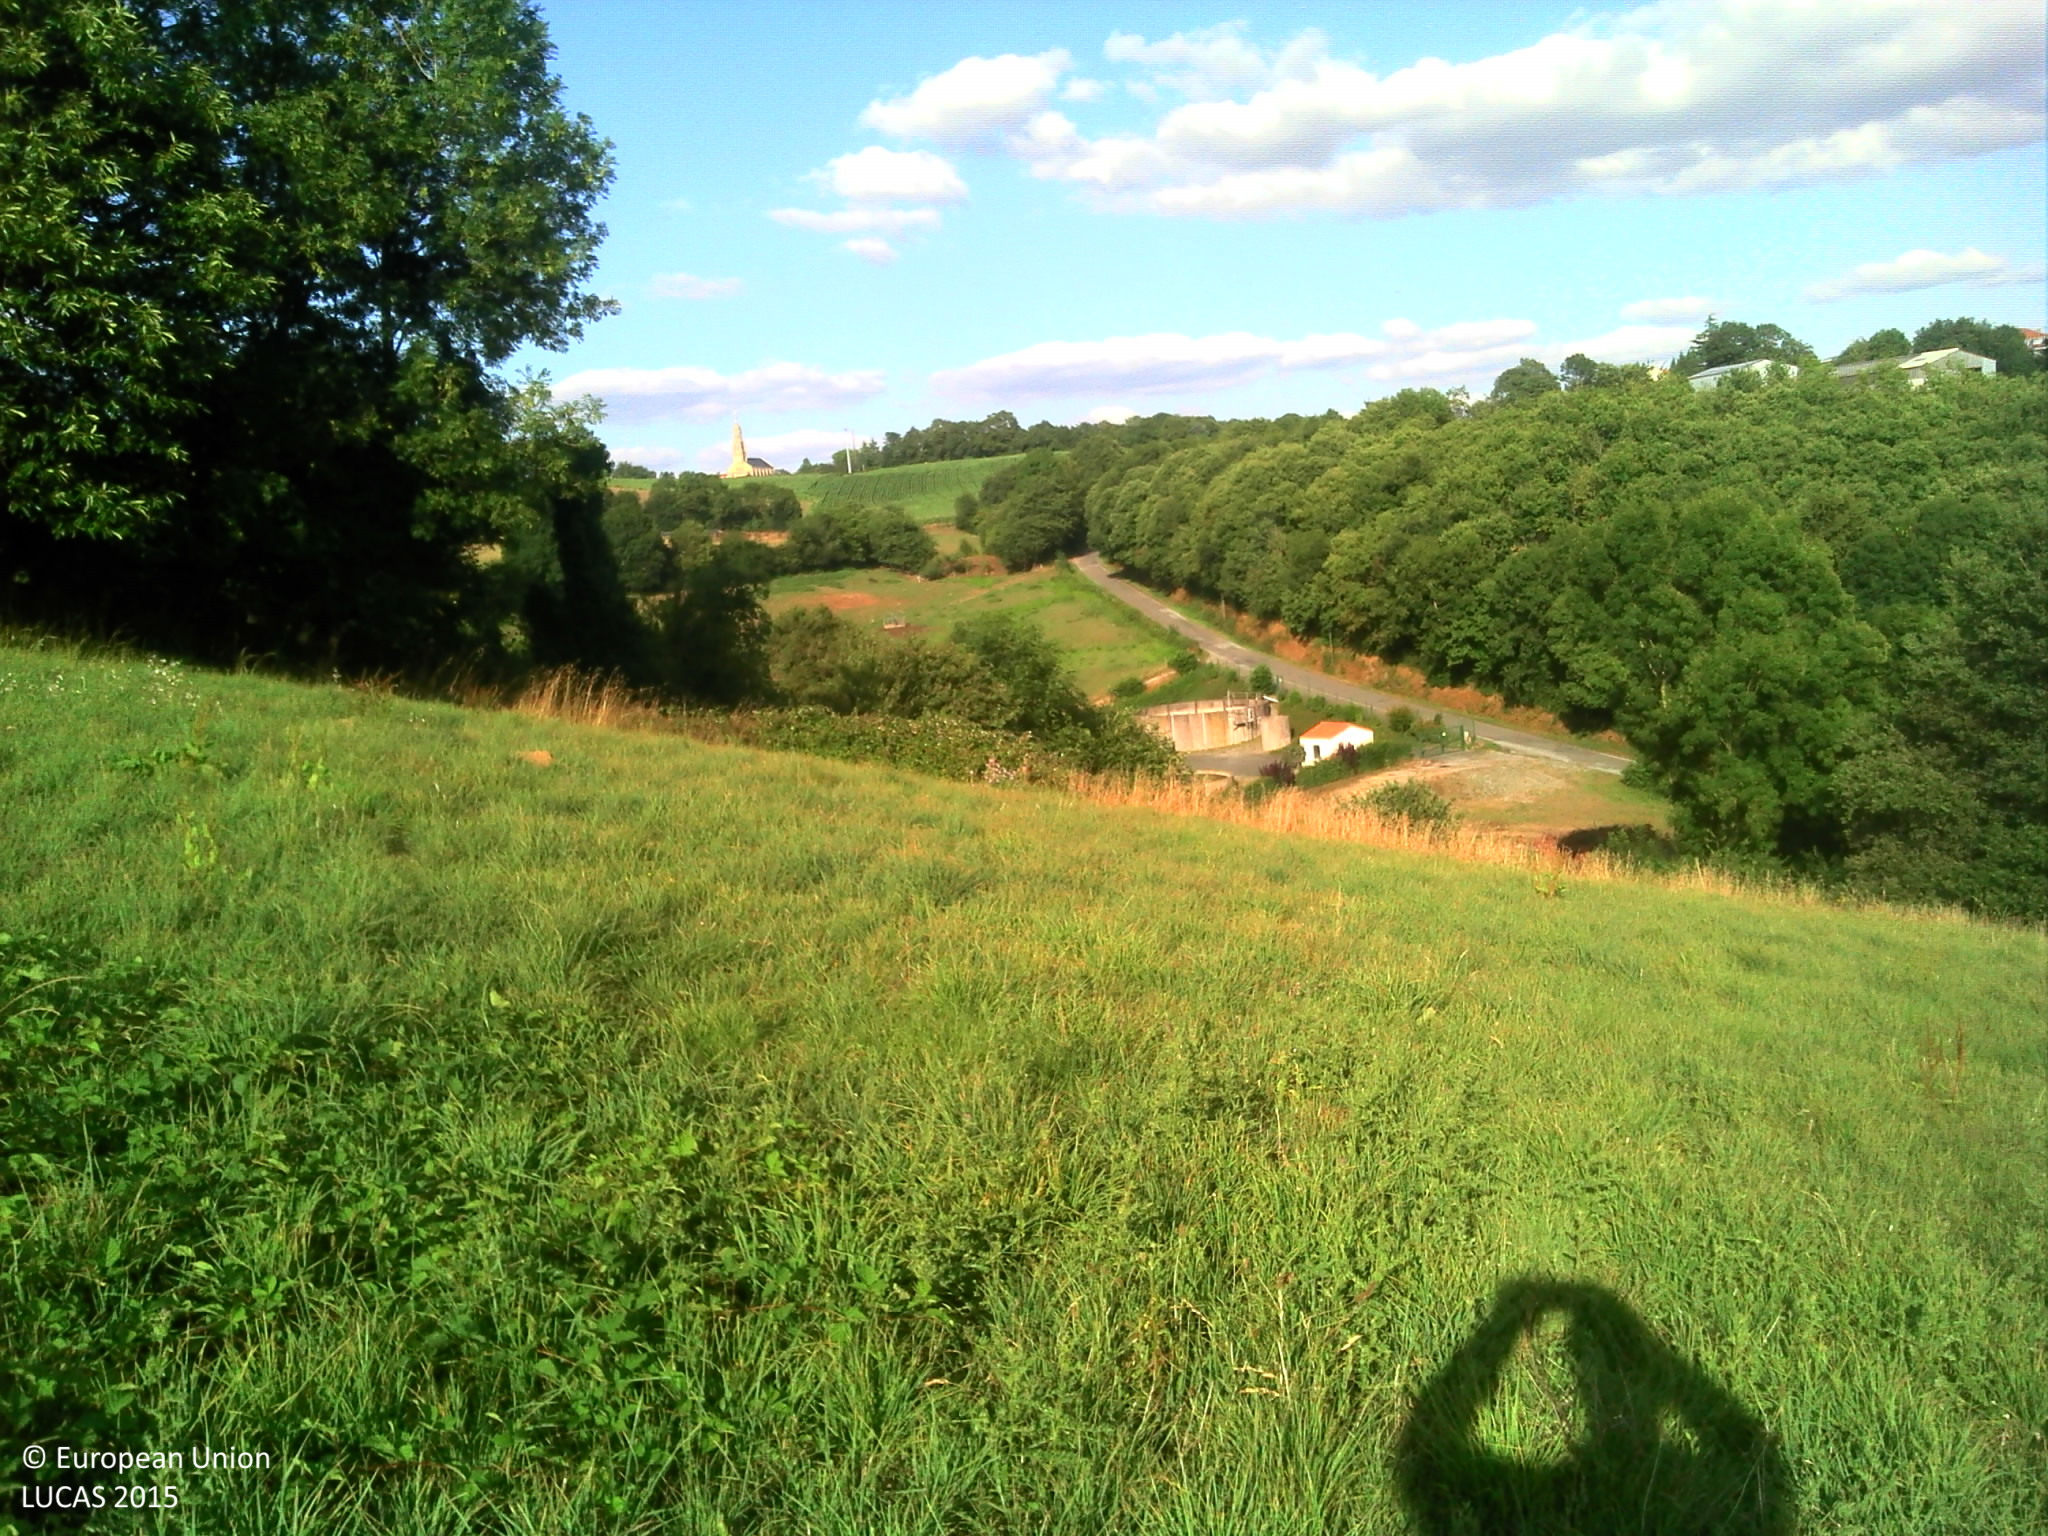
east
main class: Grassland
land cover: Grassland without tree/shrub cover
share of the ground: > 75 %
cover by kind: herbaceous plants 100 %
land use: Agriculture (excluding fallow land and kitchen gardens)
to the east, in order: Grassland without tree/shrub cover; Fences; Broadleaved woodland; Fences; Grassland without tree/shrub cover; Fences; Grassland without tree/shrub cover; Fences; Abandoned hedges; Inland fresh running water; Other bare soil; Artificial constructions in urban areas; Ditches and canals; Broadleaved woodland
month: July
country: FR
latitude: 46.8279
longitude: -0.8999
